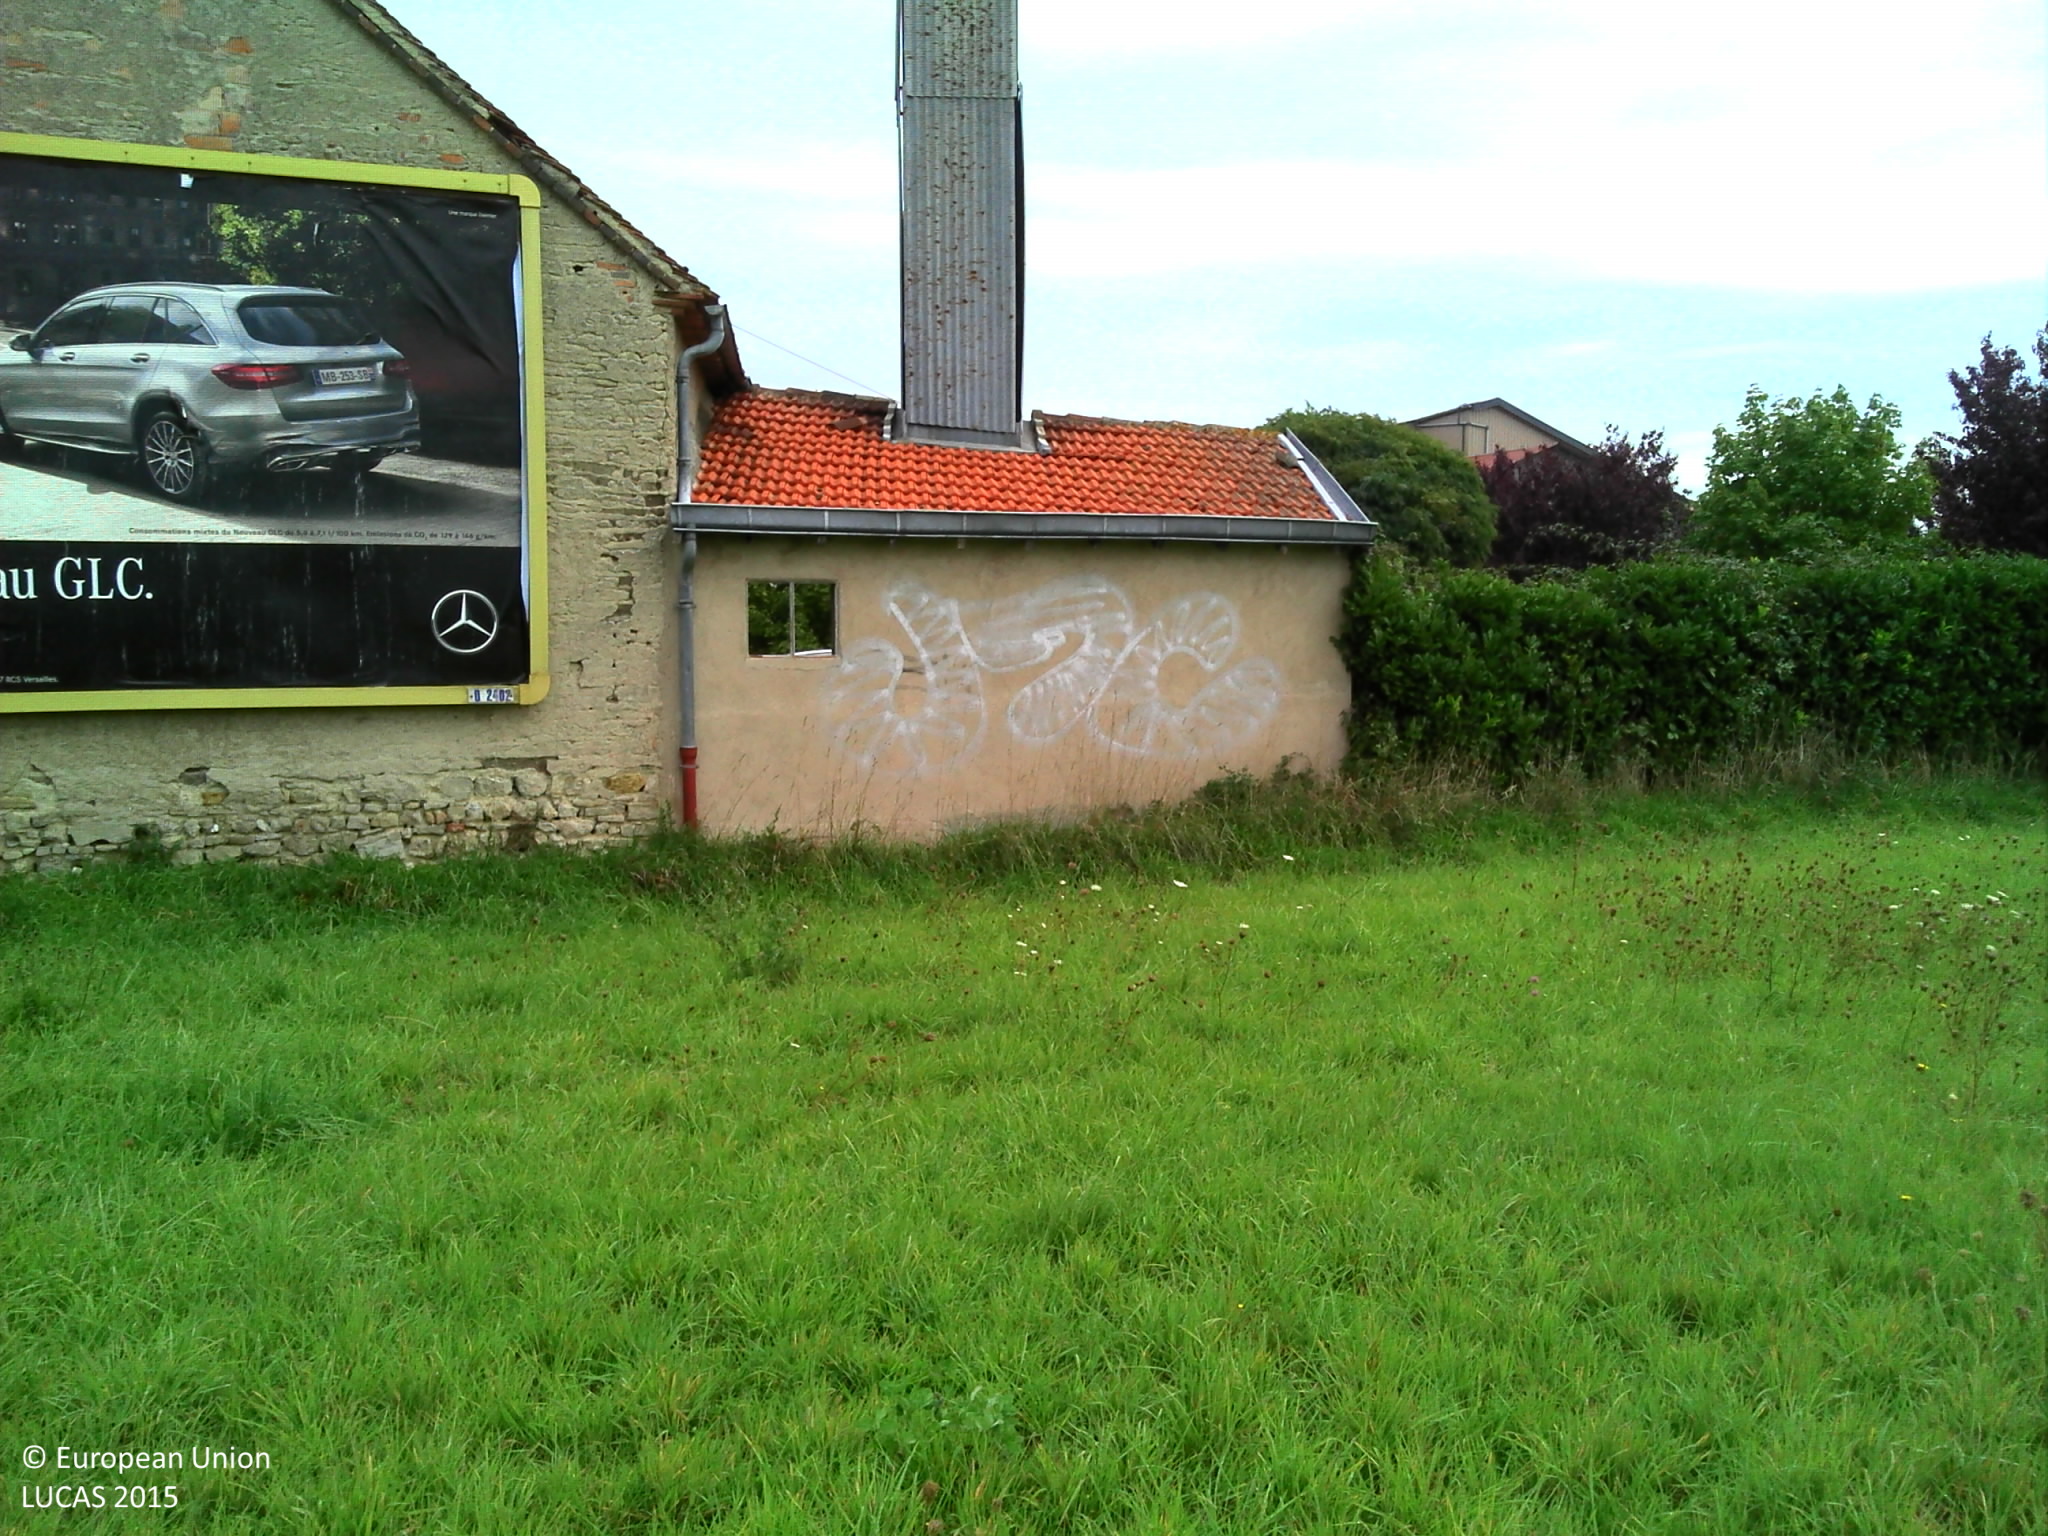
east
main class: Grassland
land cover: Grassland without tree/shrub cover
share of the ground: > 75 %
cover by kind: herbaceous plants 100 %
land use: Agriculture (excluding fallow land and kitchen gardens)
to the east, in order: Grassland without tree/shrub cover; Artificial constructions in urban areas; Grassland with sparse tree/shrub cover; Fences; Vineyards; Artificial constructions in urban areas
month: October
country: FR
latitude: 45.9964
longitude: 3.2986
